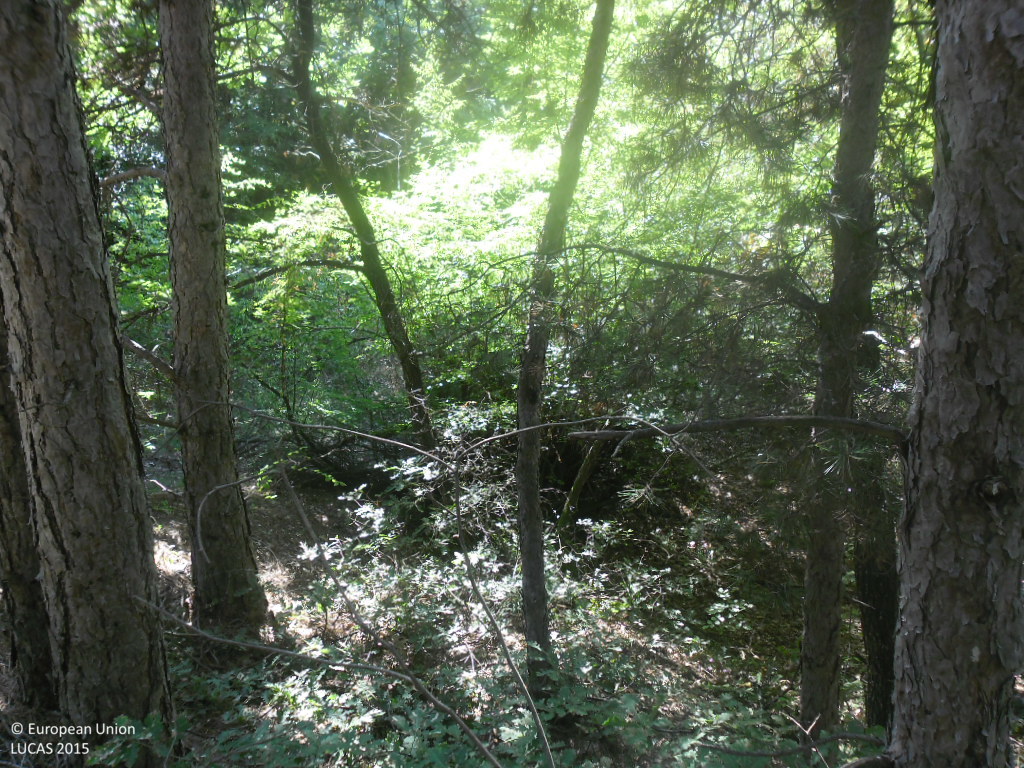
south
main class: Woodland
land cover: Pine dominated mixed woodland
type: hemiboreal forest and nemoral coniferous forest and mixed broadleaved-coniferous forest
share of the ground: > 75 %
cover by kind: coniferous forest trees 75 %, broadleaved forest trees 25 %
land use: Forestry
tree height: > 5 m
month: October
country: BG
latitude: 41.3941
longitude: 23.2594
